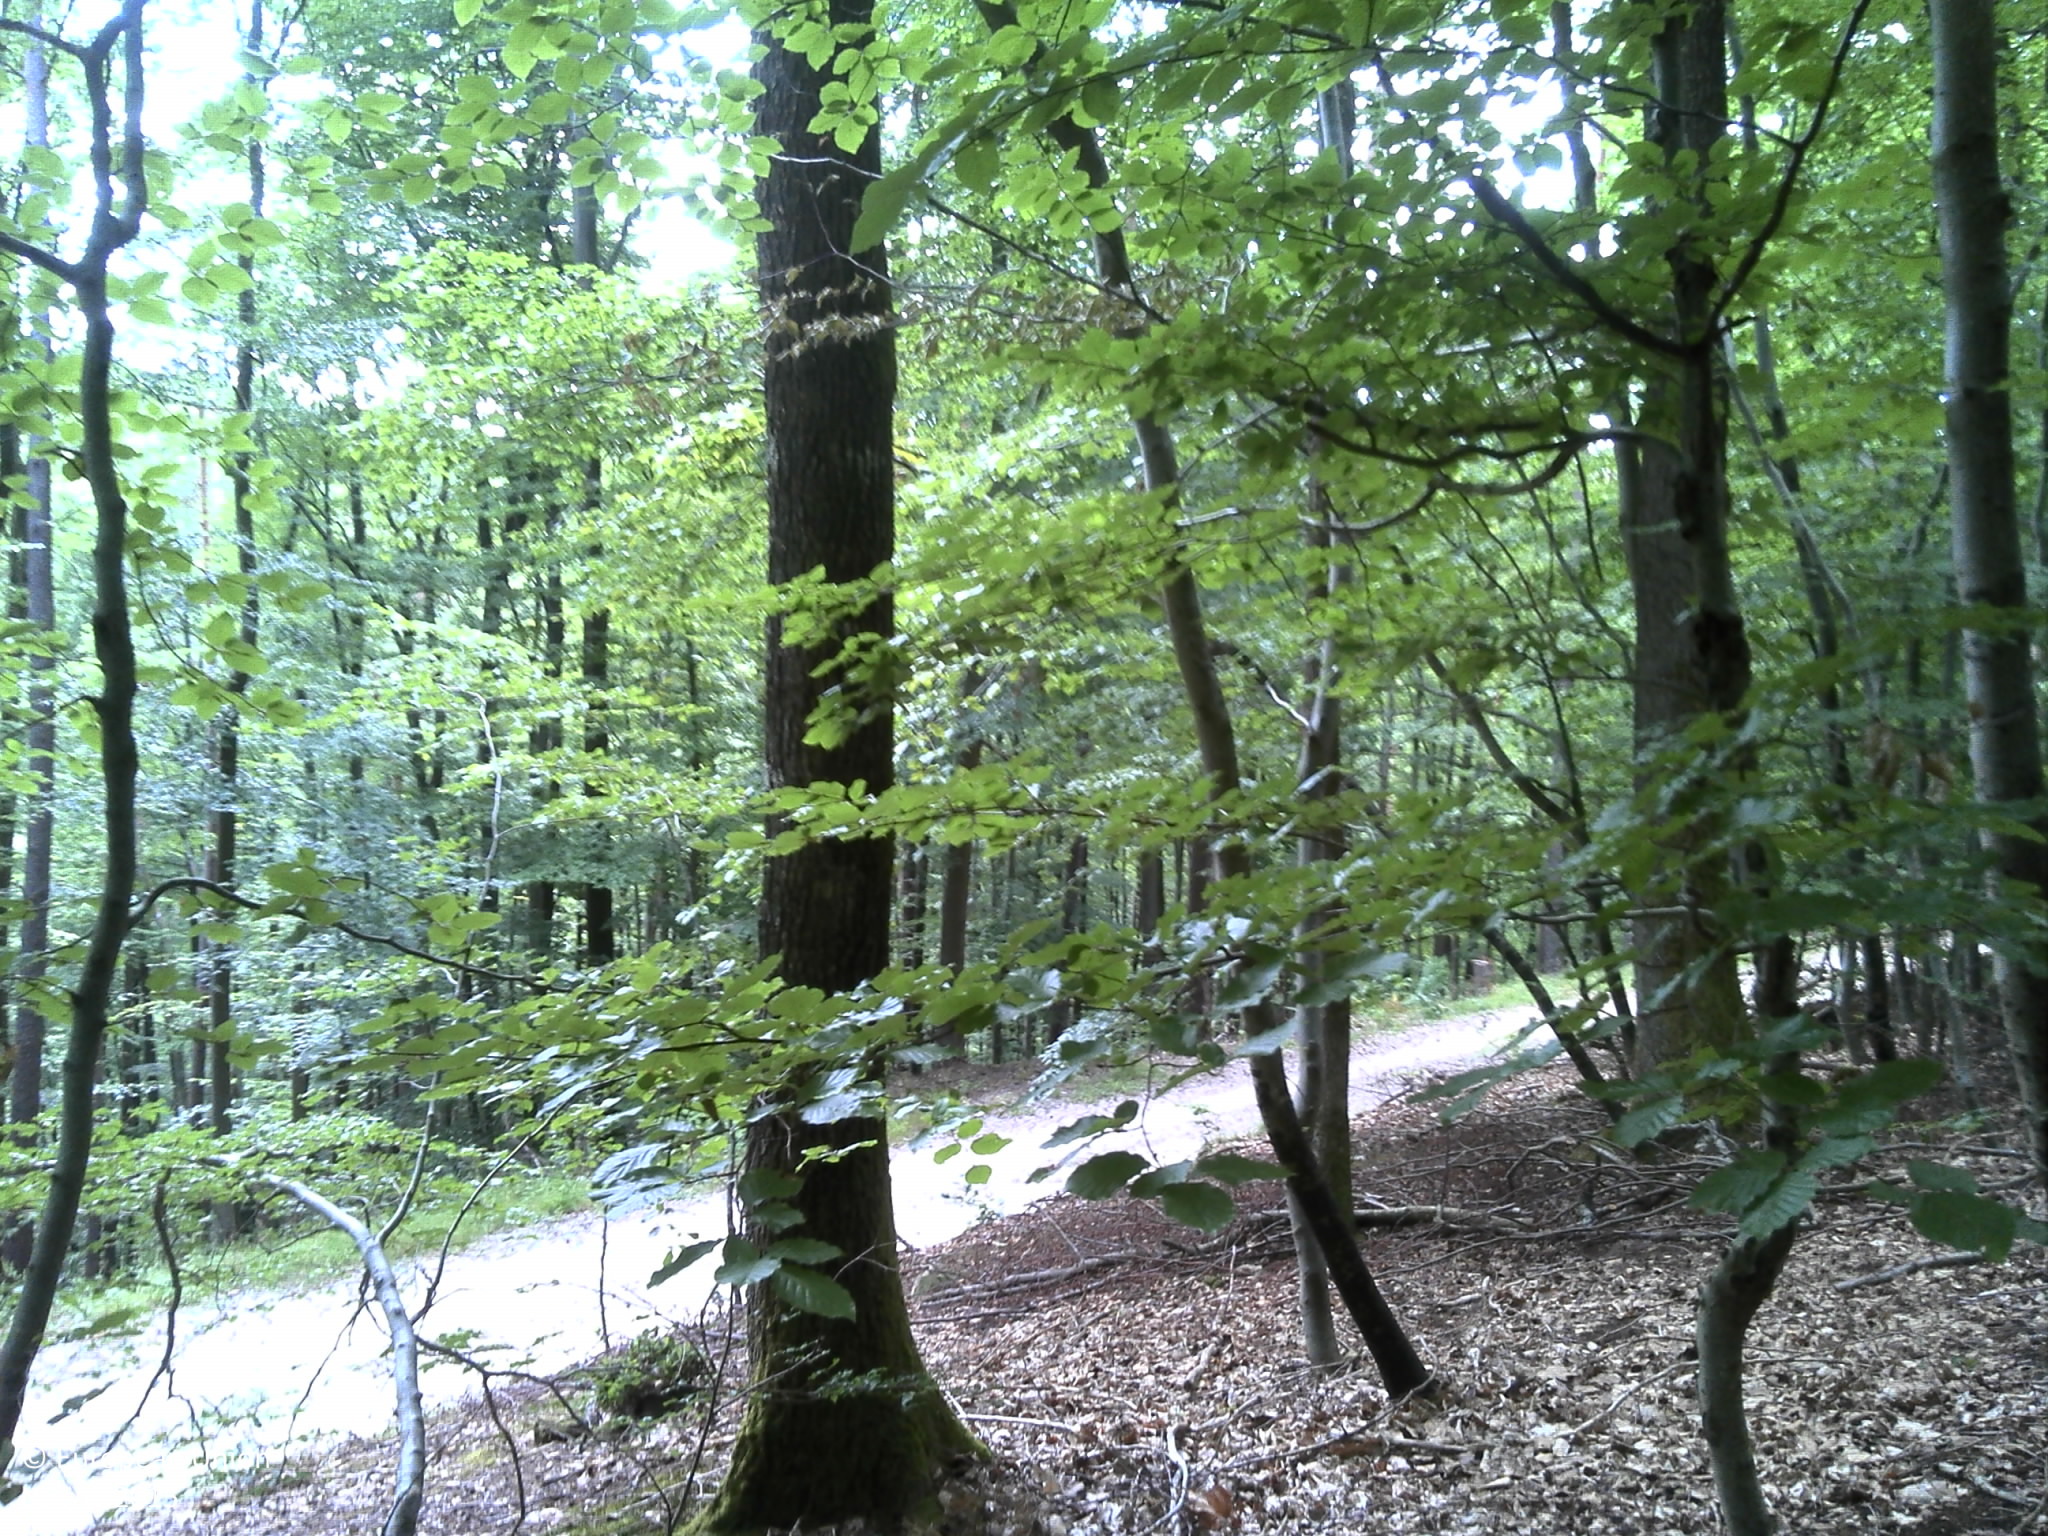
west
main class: Woodland
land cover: Broadleaved woodland
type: acidophilous oak and oak-birch forest
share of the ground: > 75 %
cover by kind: broadleaved forest trees 95 %, unconsolidated bare surface 5 %
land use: Forestry
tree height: > 5 m
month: July
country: FR
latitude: 49.0939
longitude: 7.4396
